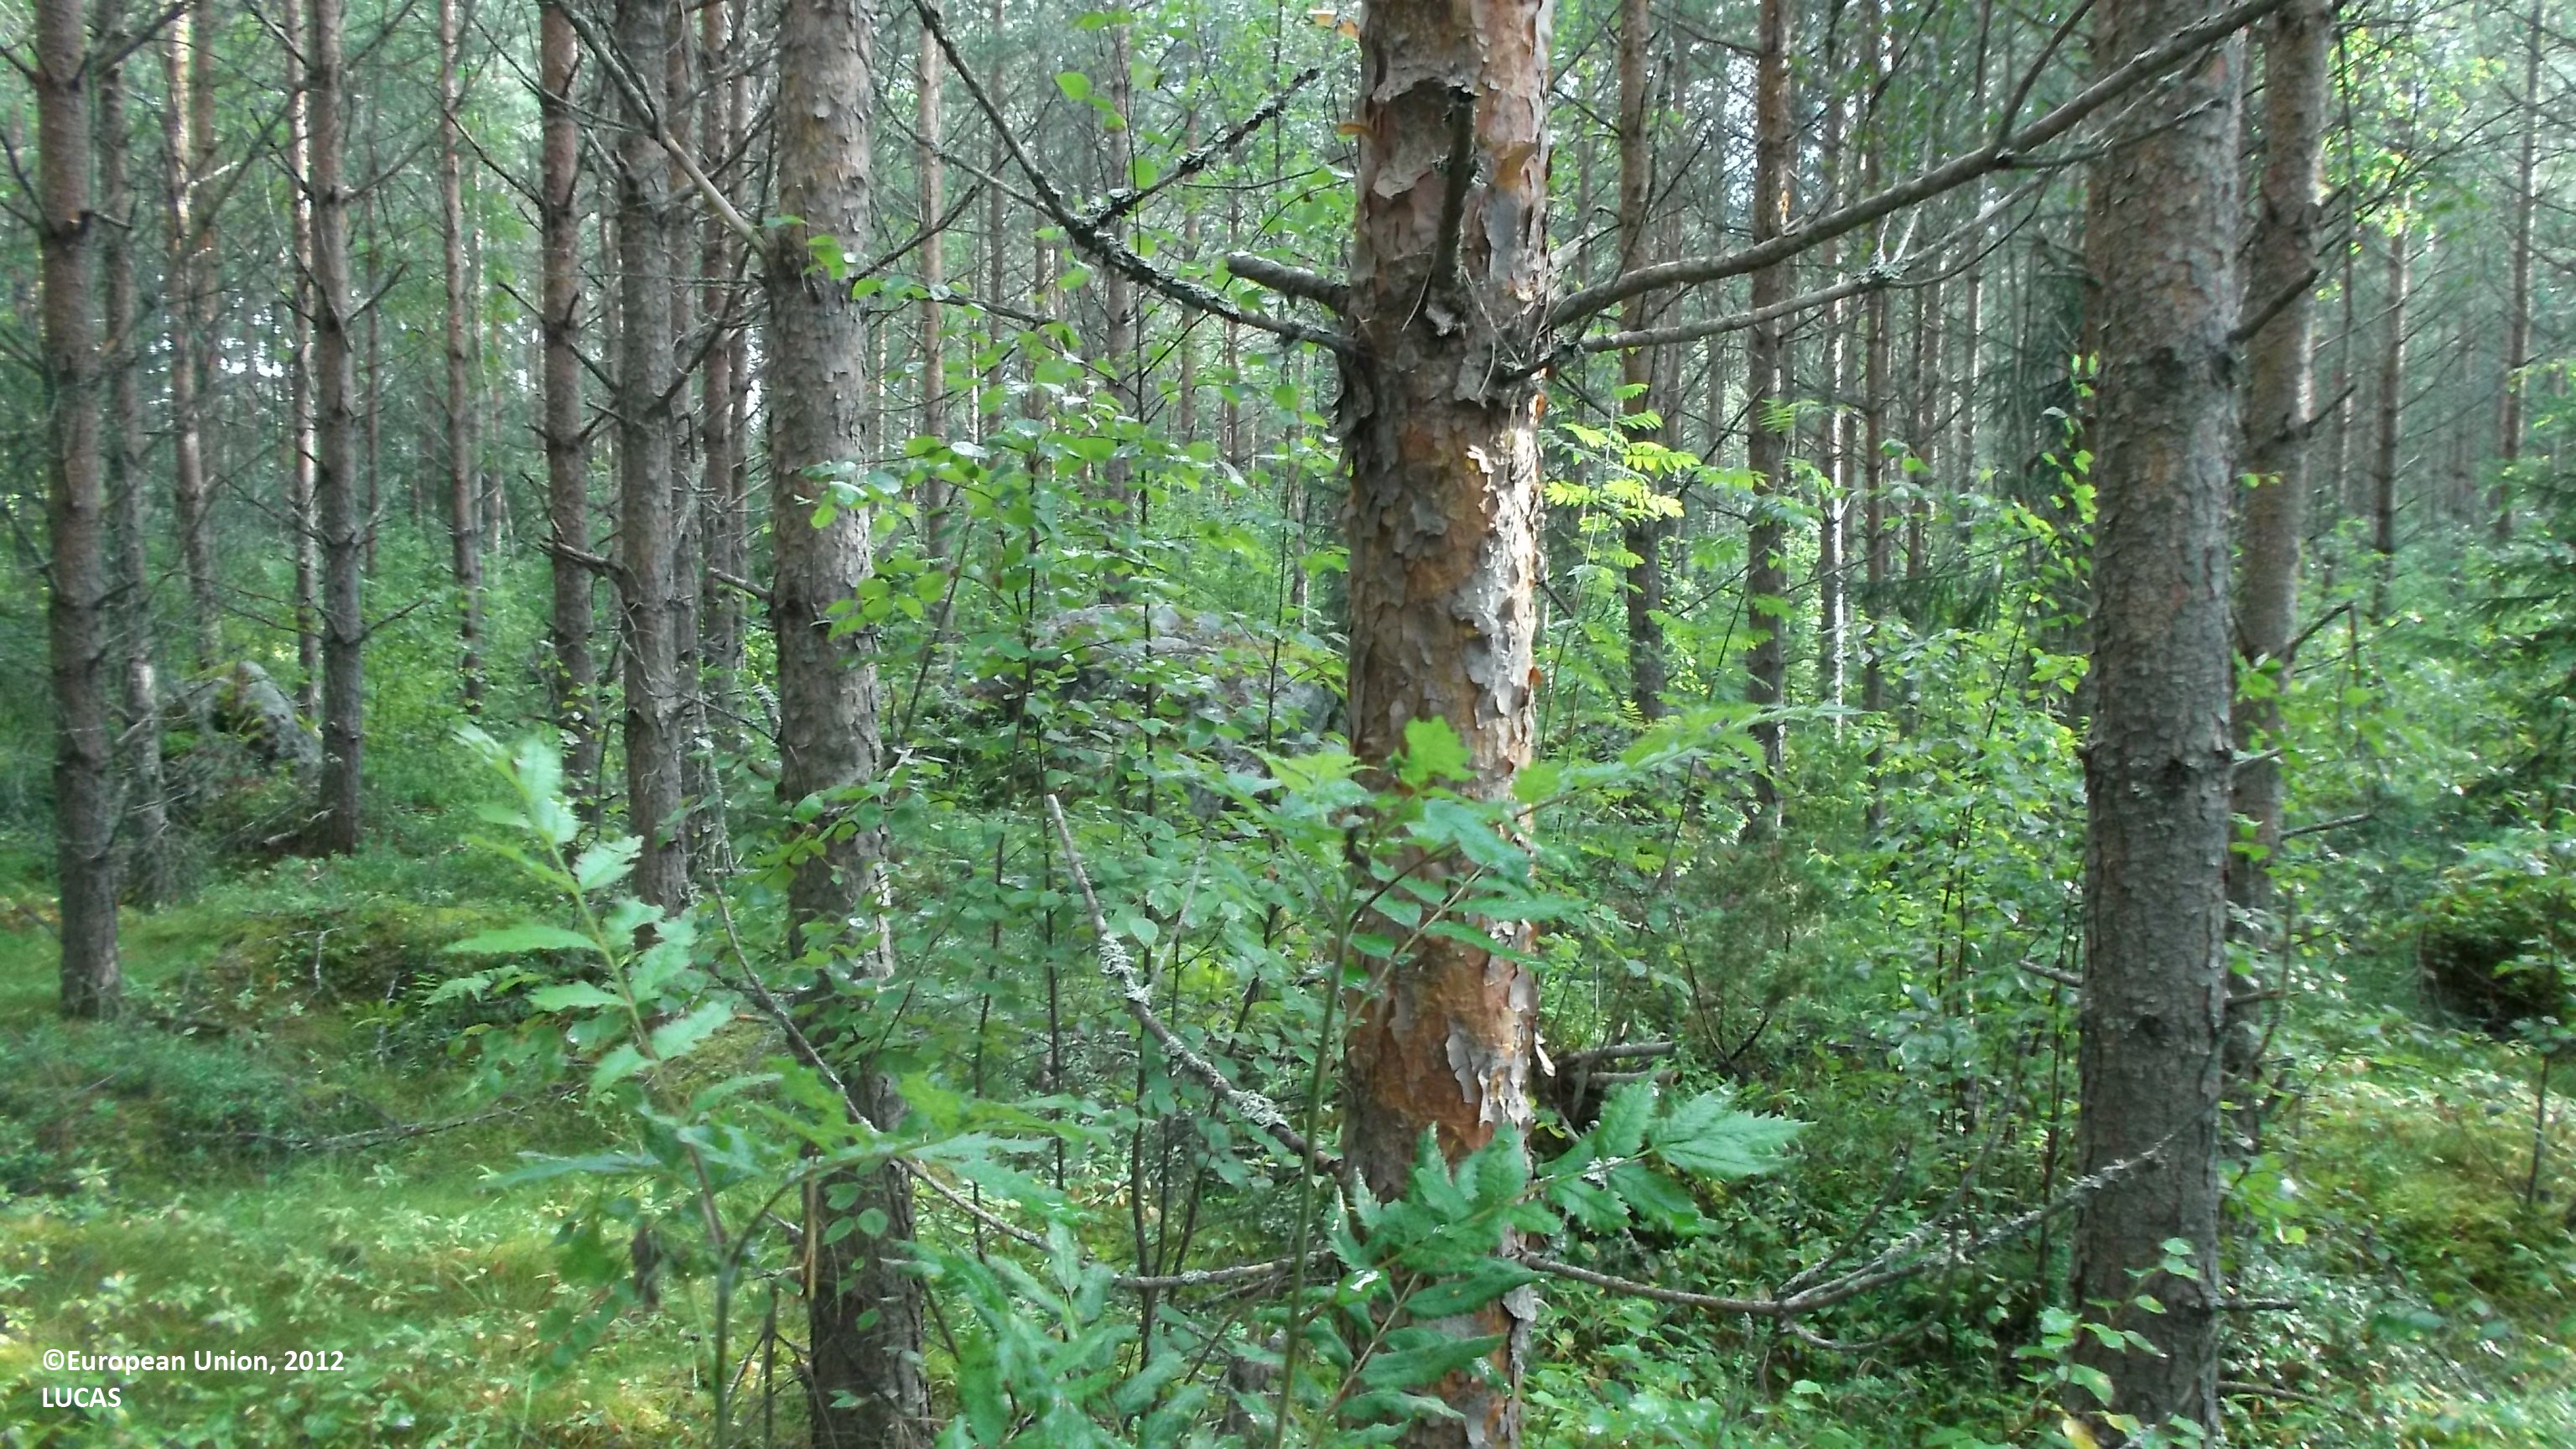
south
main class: Woodland
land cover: Pine dominated coniferous woodland
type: boreal forest
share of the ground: 50 - 75 %
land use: Forestry
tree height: > 5 m
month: August
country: FI
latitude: 63.9320
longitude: 23.4574
